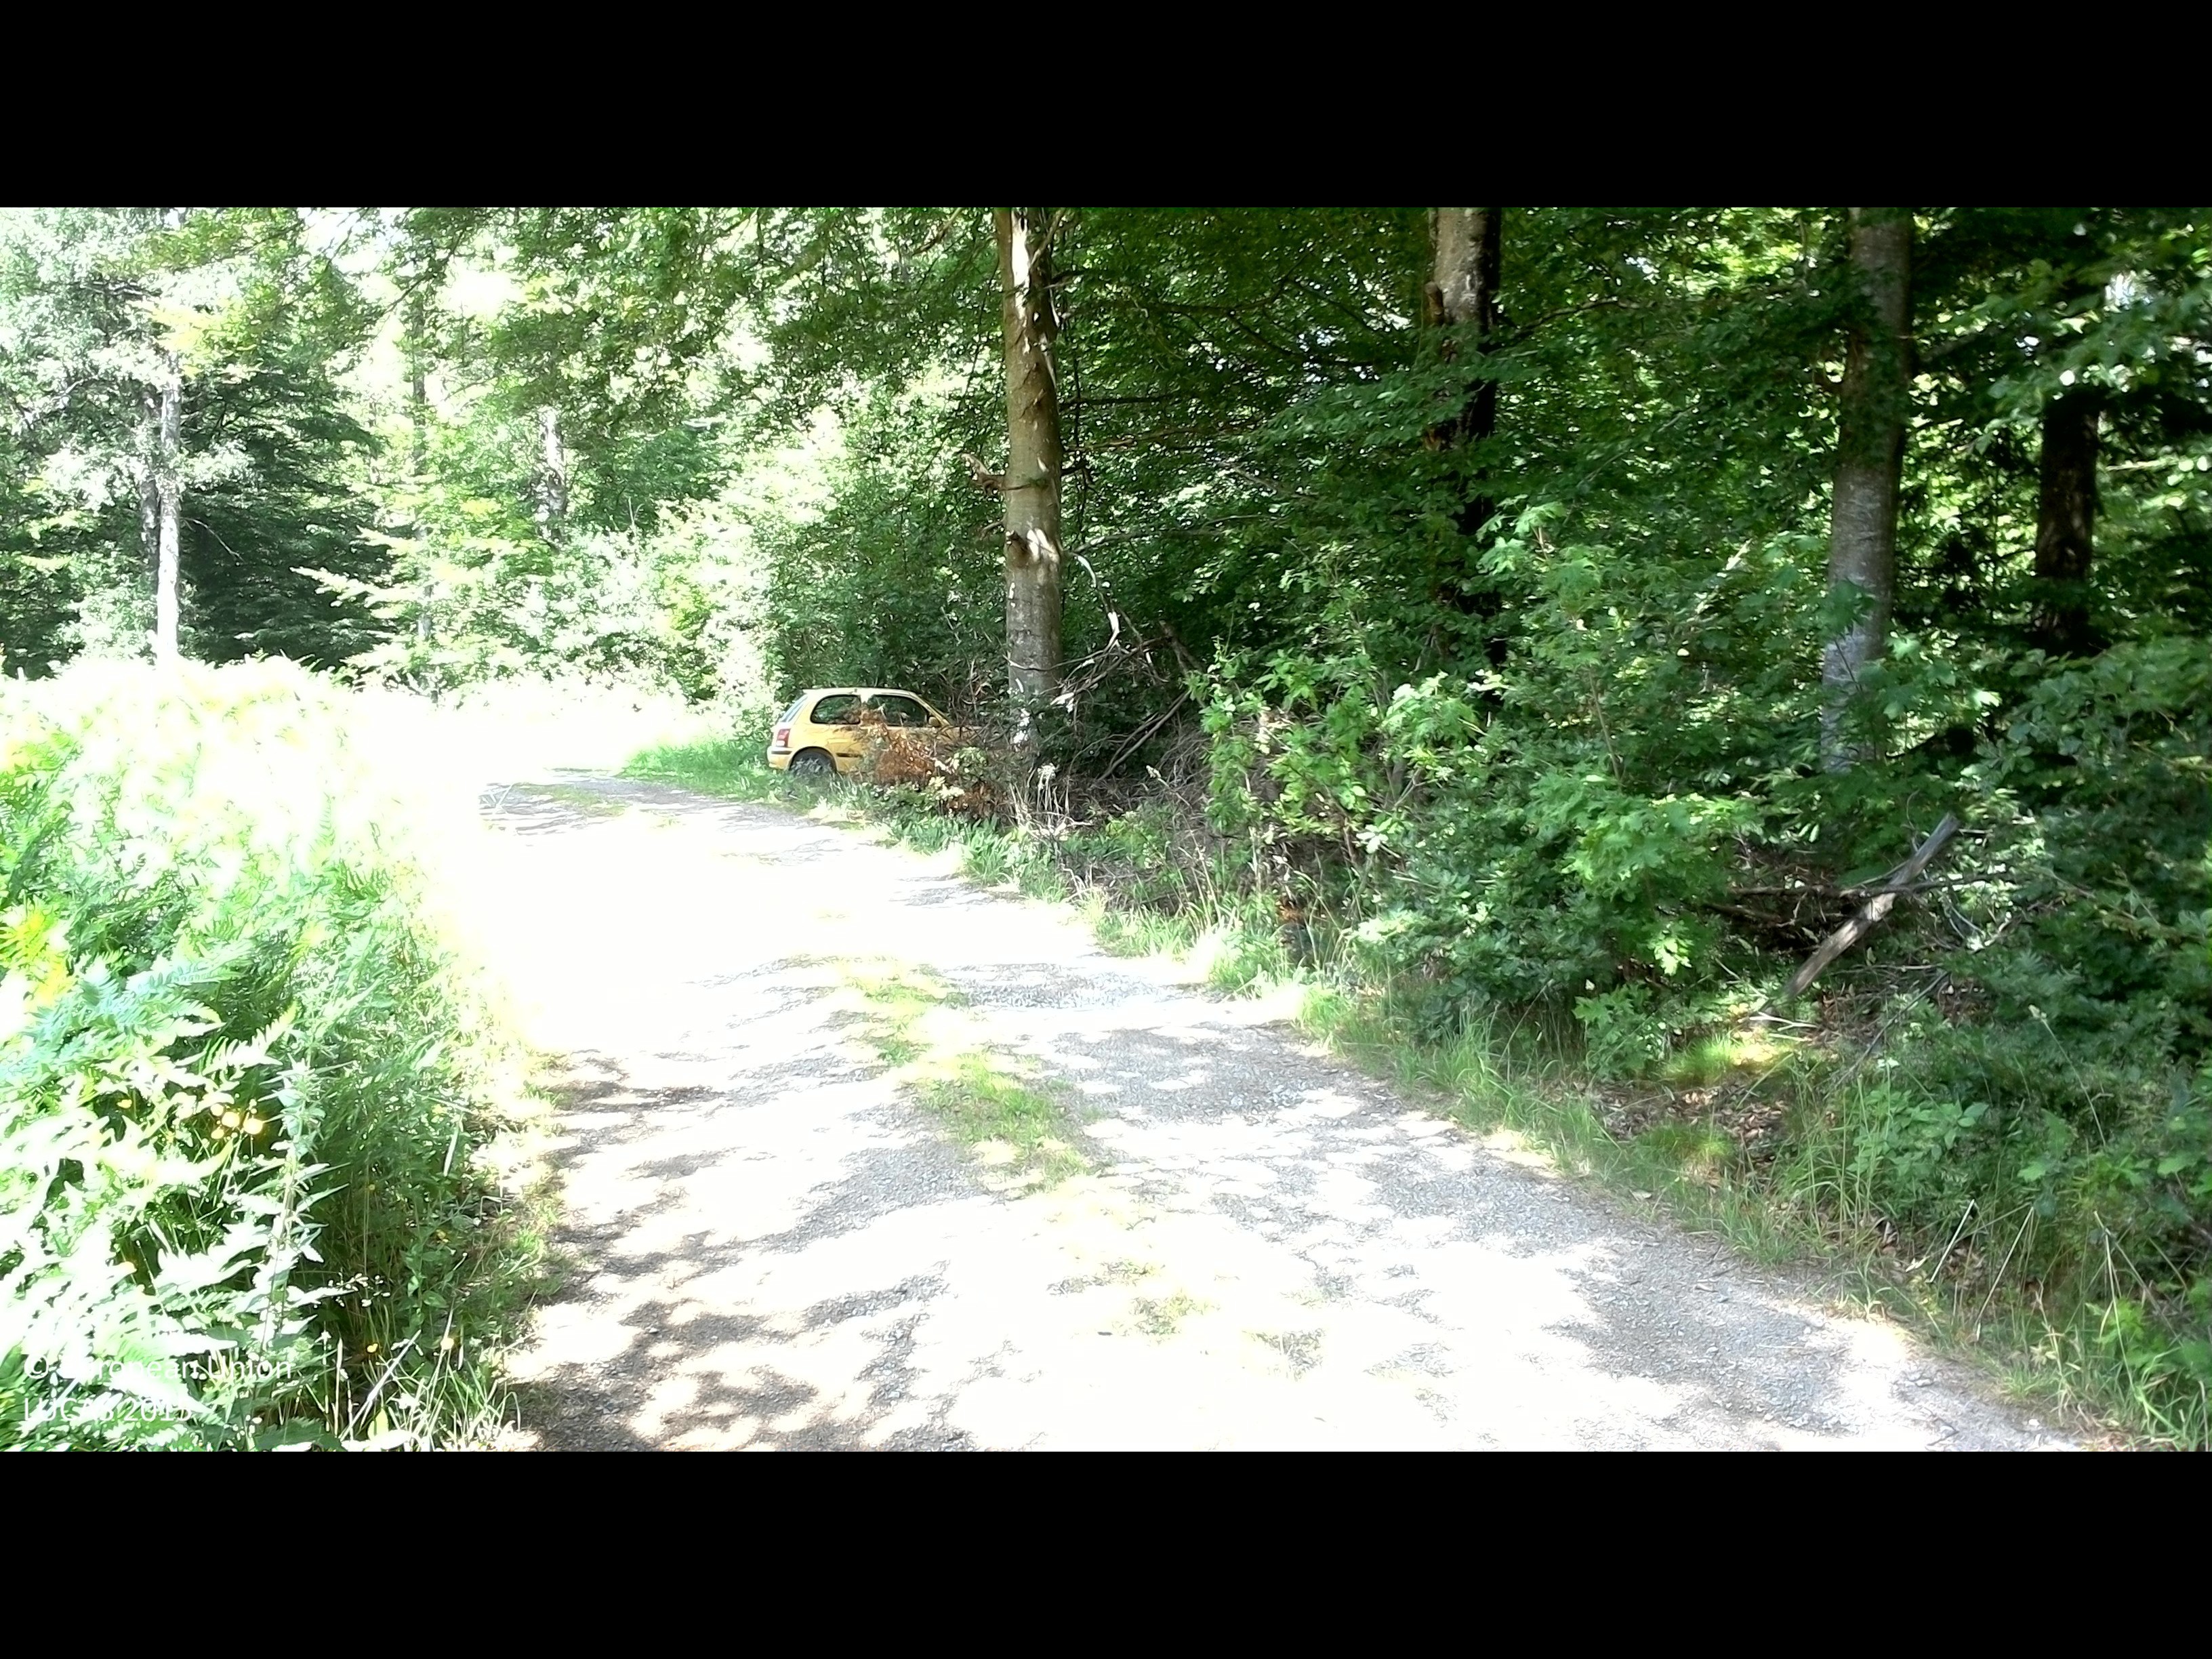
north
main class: Woodland
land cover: Broadleaved woodland
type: beech forest
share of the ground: > 75 %
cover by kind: broadleaved forest trees 75 %, herbaceous plants 20 %, shrubs 5 %
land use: Forestry
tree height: > 5 m
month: July
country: SE
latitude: 56.3709
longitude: 15.1958
